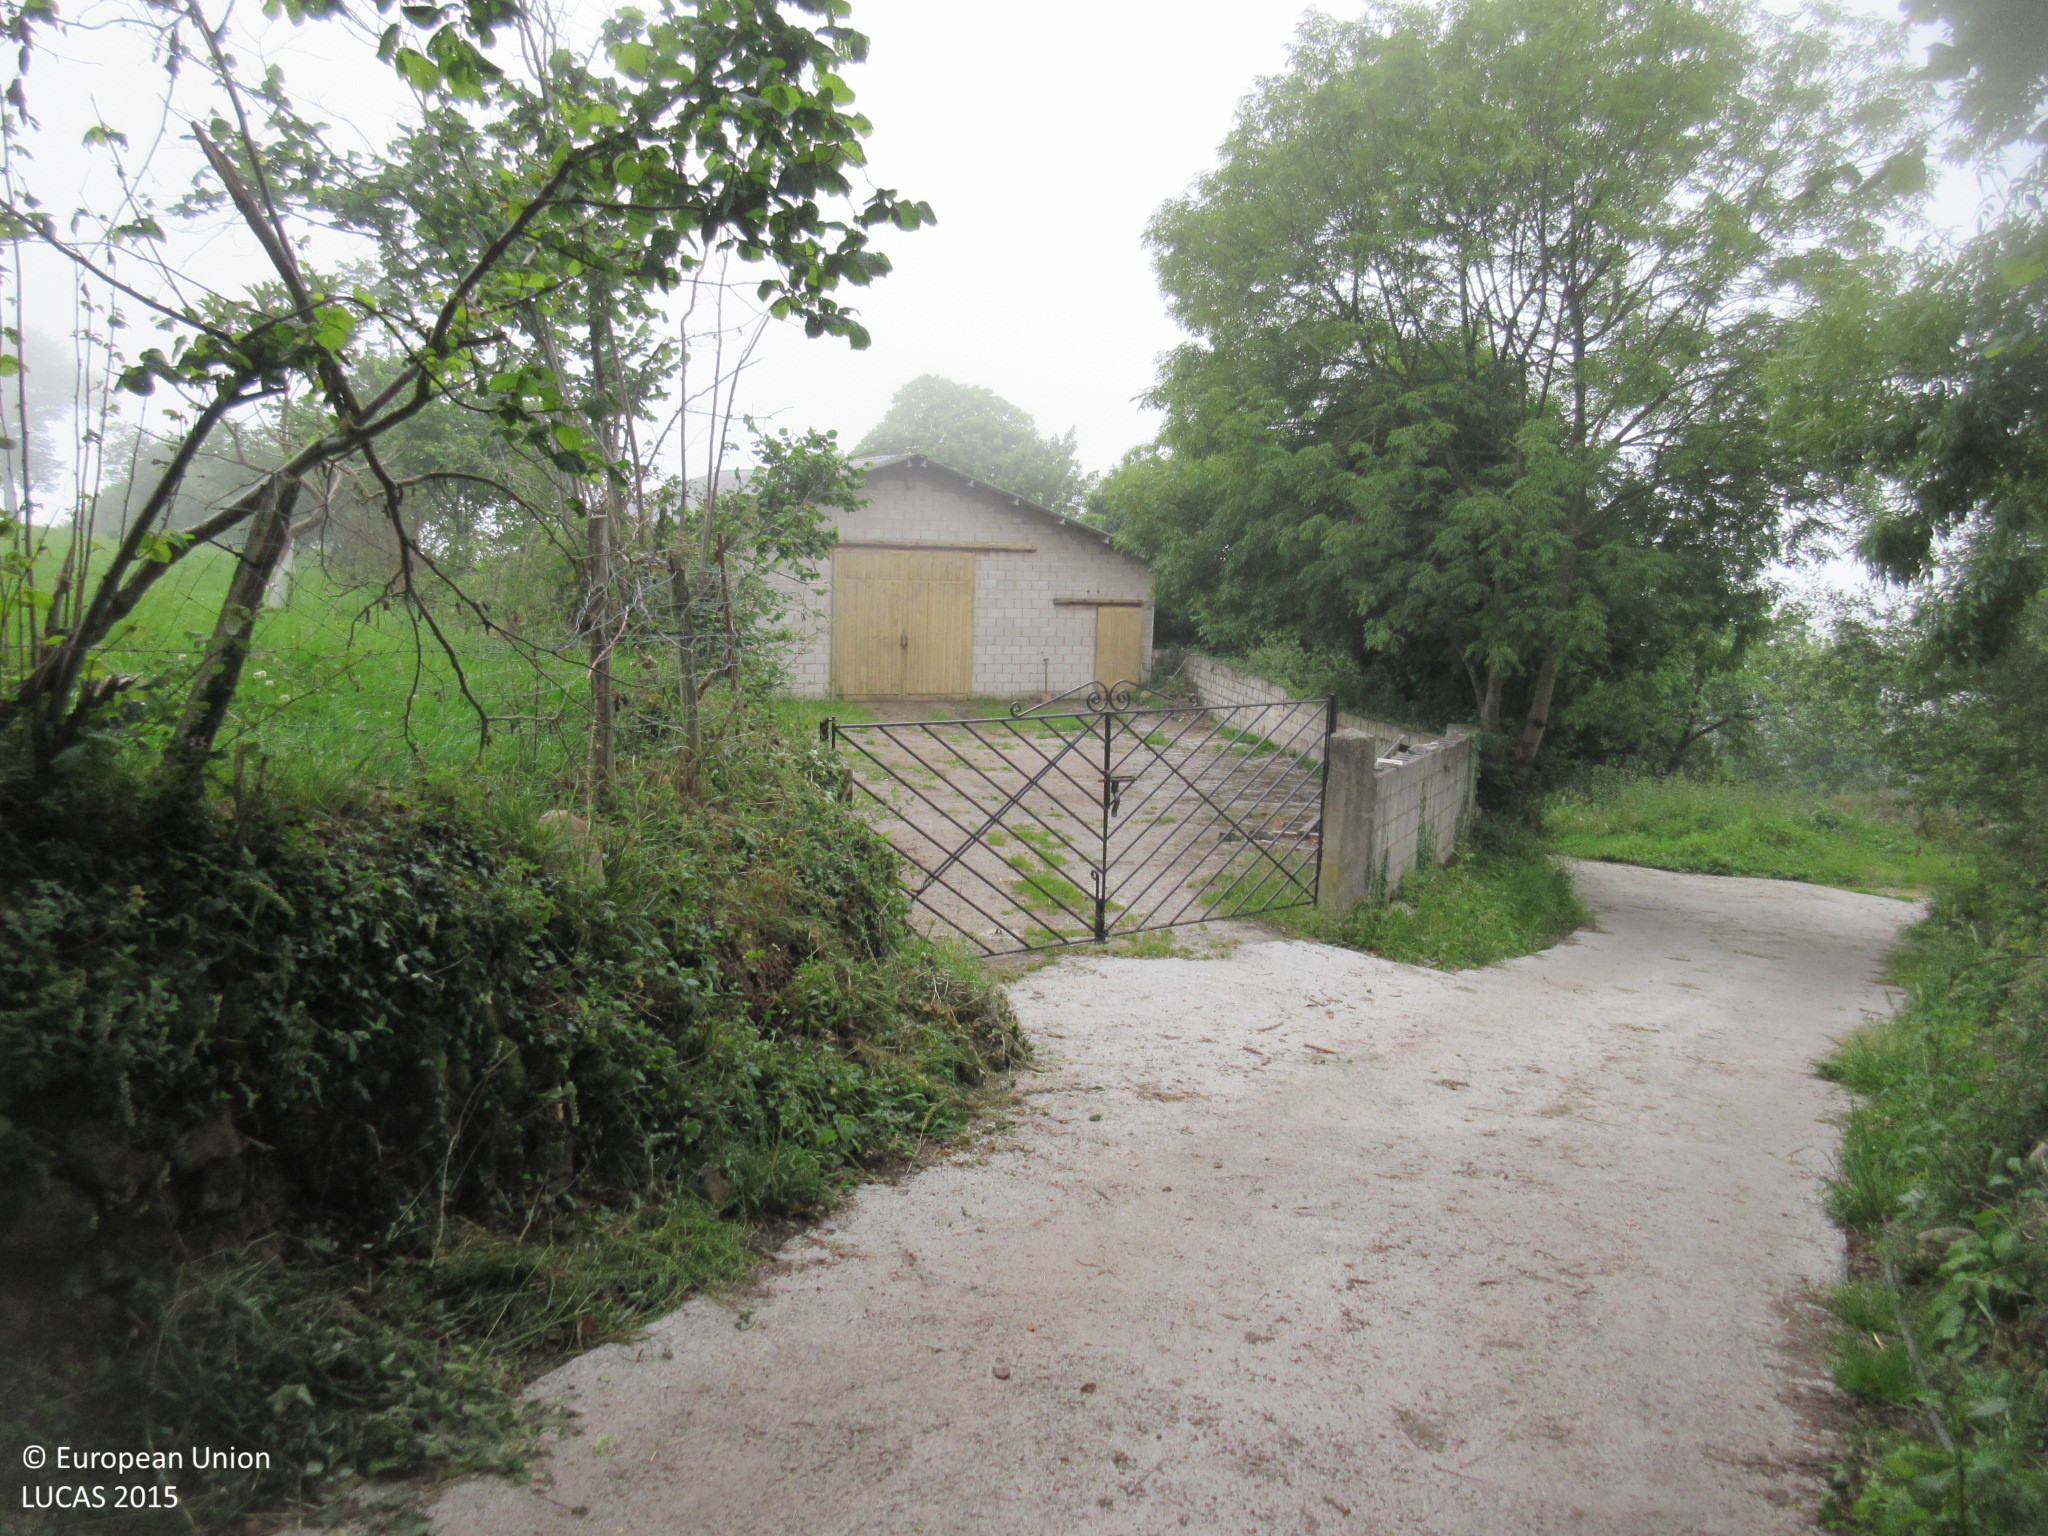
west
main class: Grassland
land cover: Grassland without tree/shrub cover
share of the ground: > 75 %
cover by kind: herbaceous plants 100 %
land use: Agriculture (excluding fallow land and kitchen gardens)
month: June
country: ES
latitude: 43.2893
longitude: -6.3044
